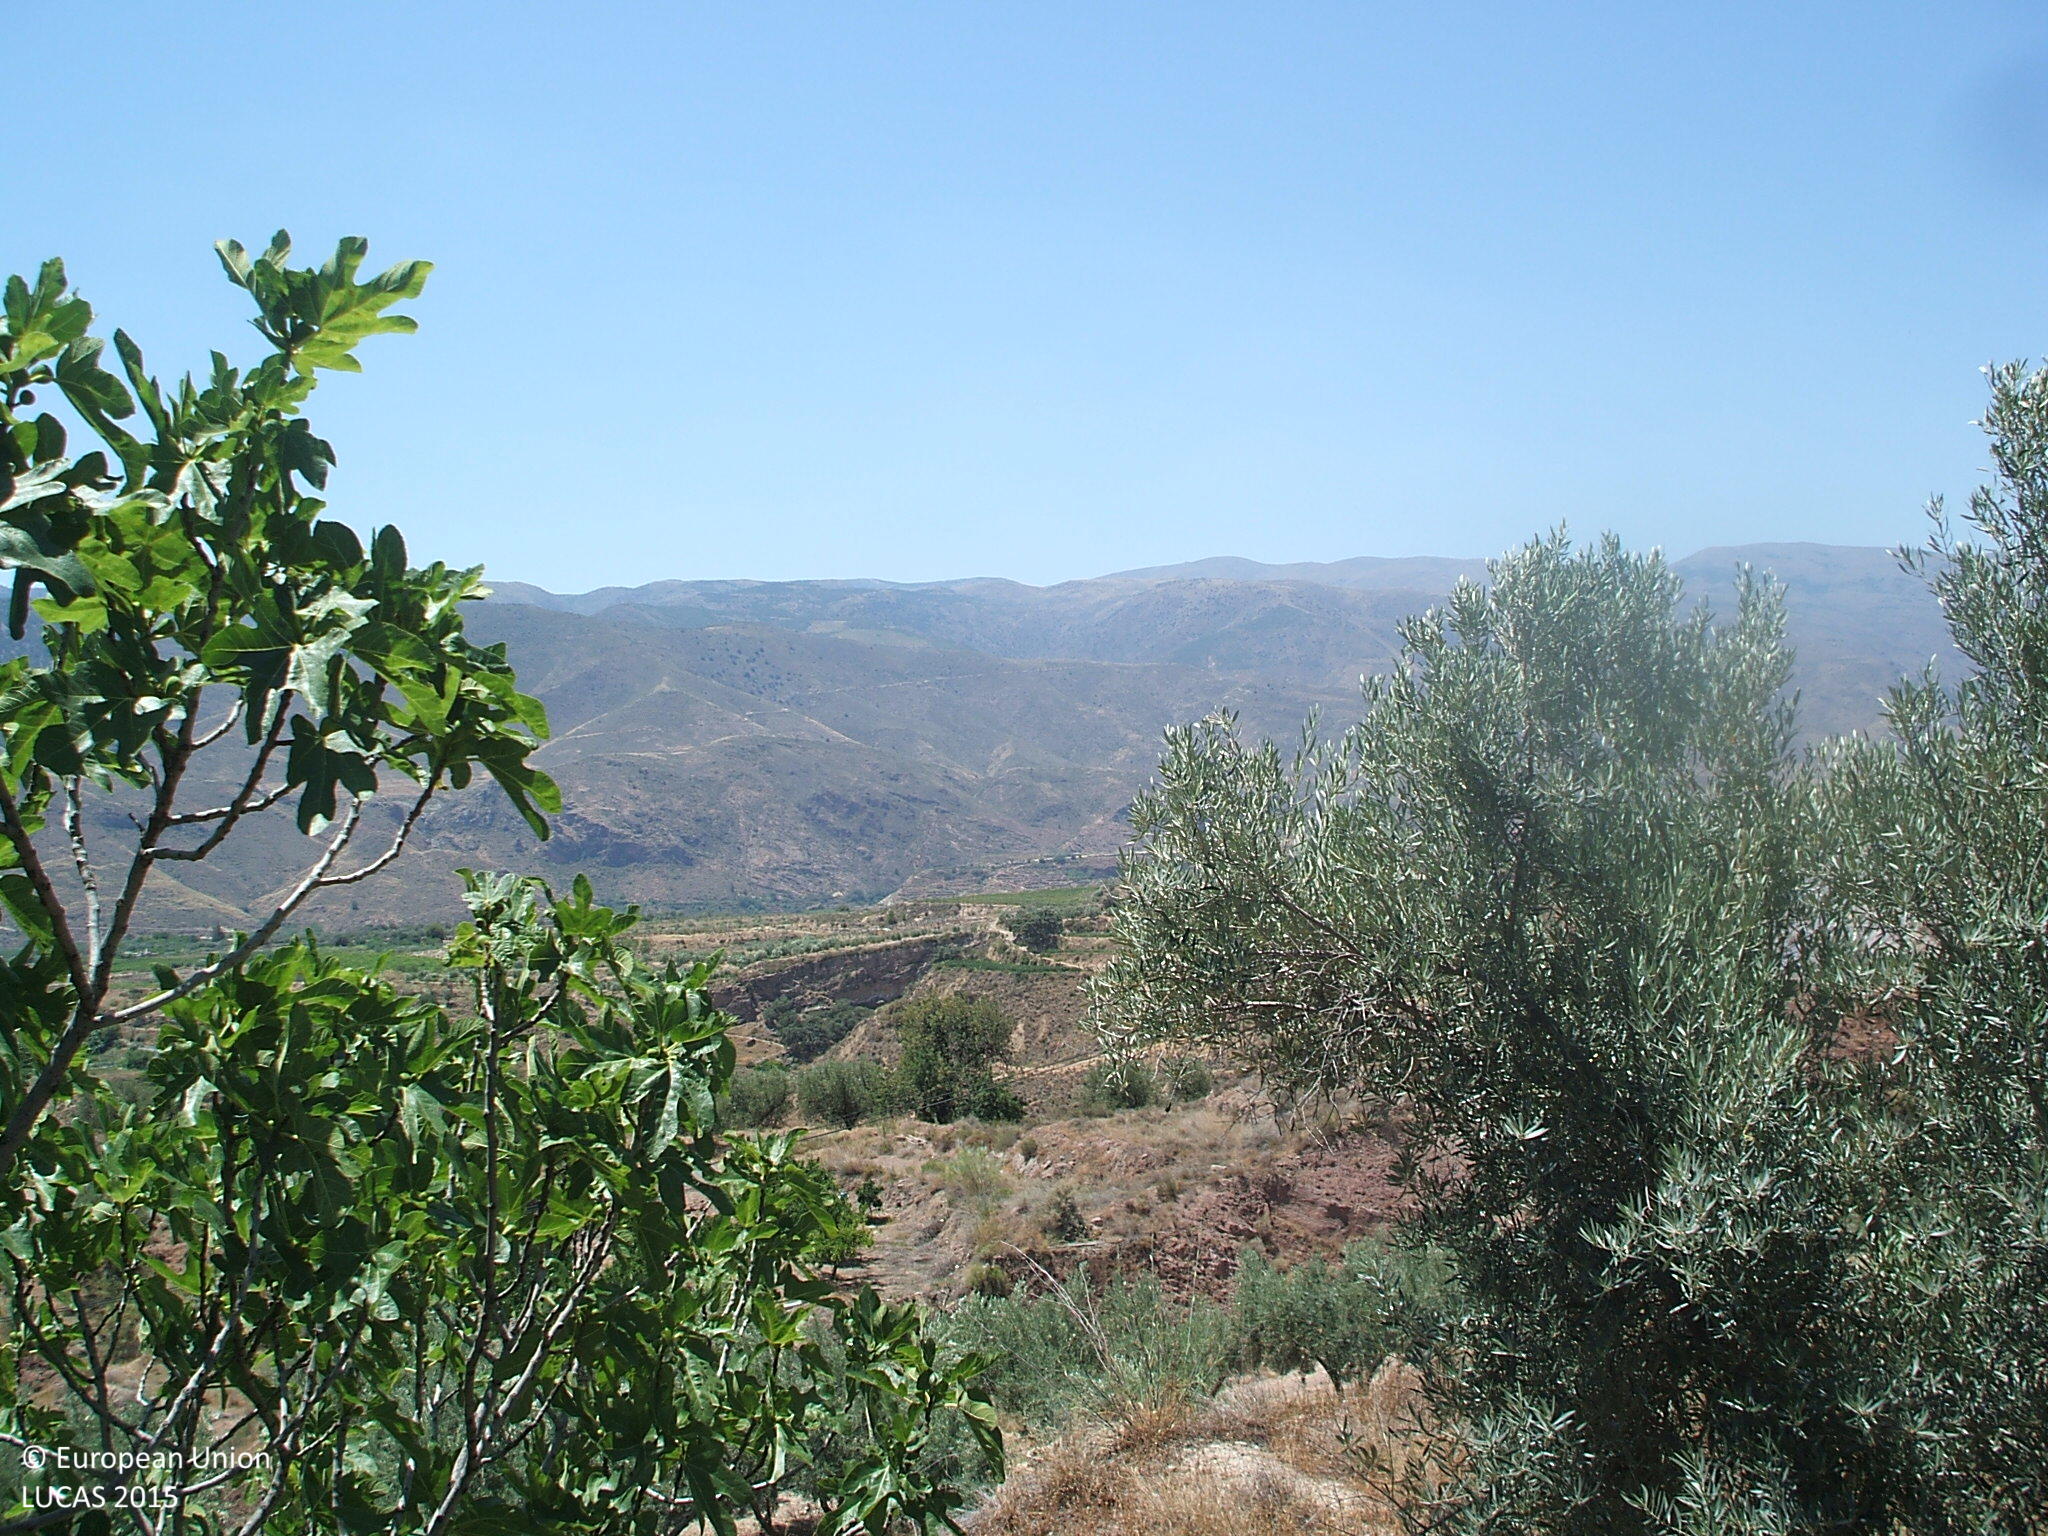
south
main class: Cropland
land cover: Olive groves
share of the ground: > 75 %
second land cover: Spontaneously vegetated surfaces
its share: 25 - 50 %
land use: Agriculture (excluding fallow land and kitchen gardens)
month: June
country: ES
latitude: 37.0127
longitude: -2.7584
